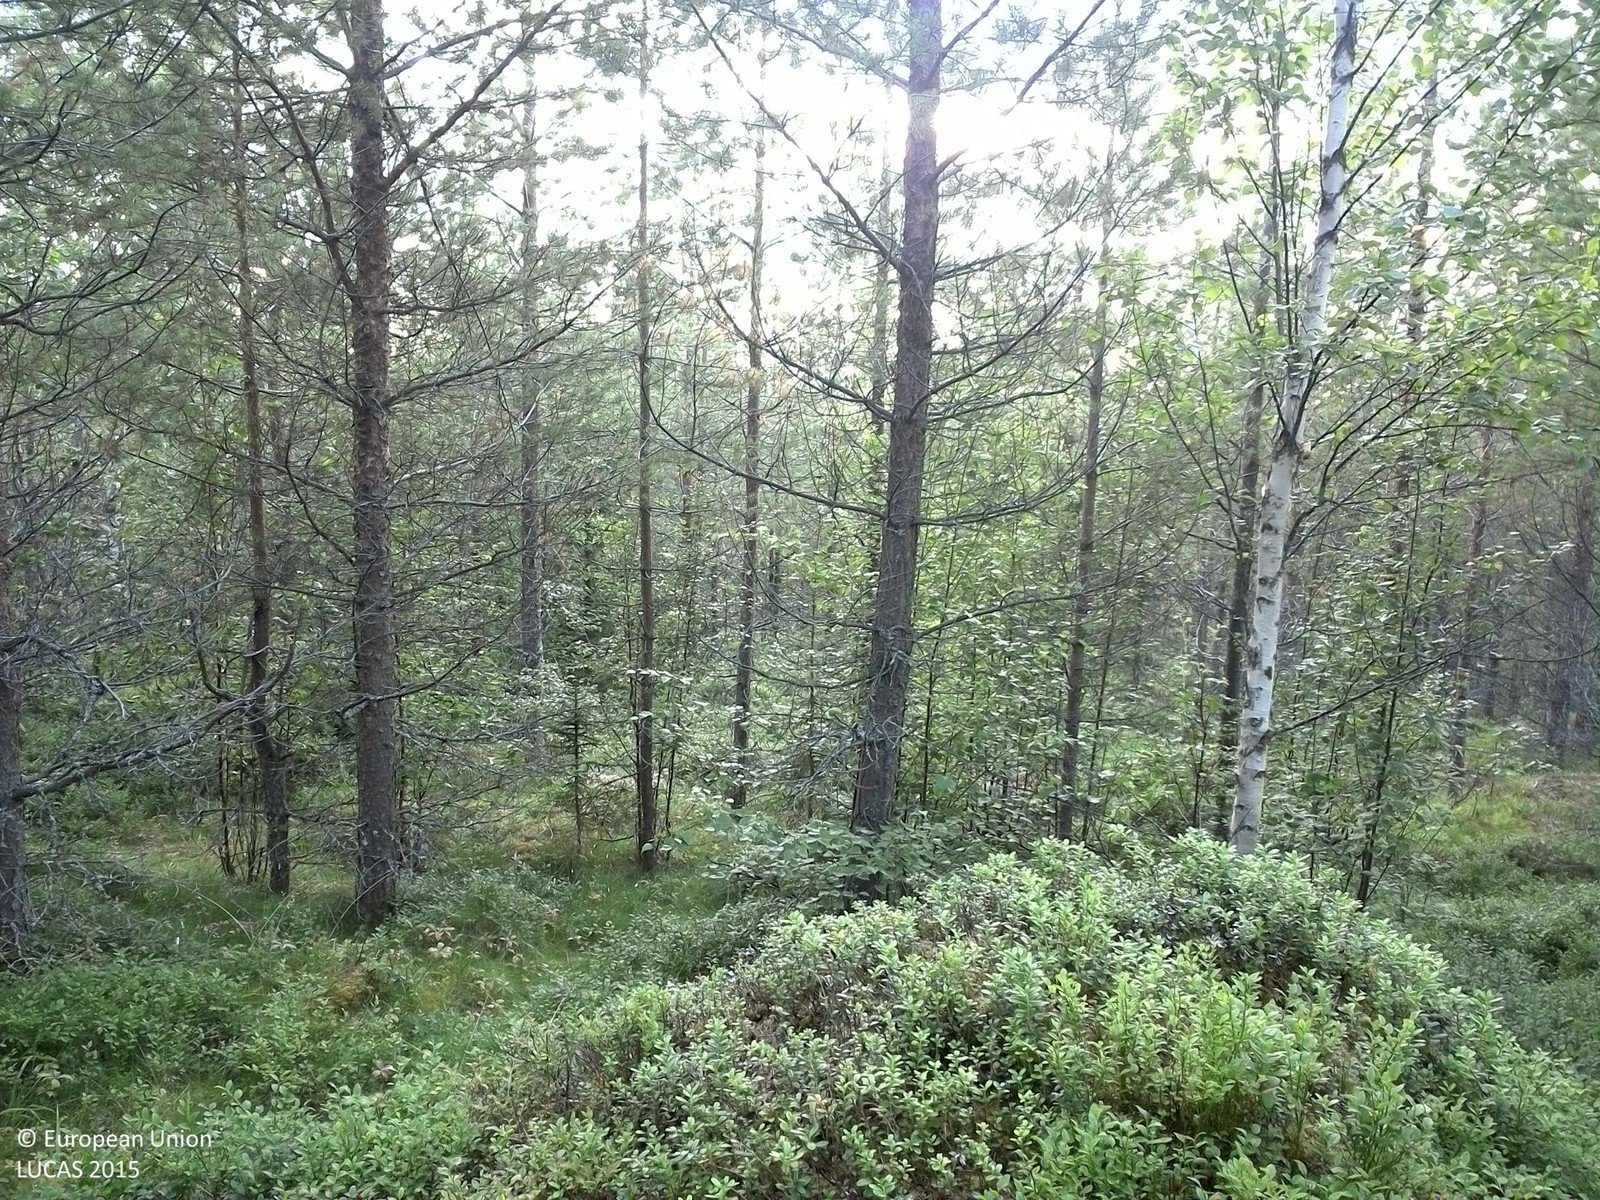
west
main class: Woodland
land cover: Pine dominated mixed woodland
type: boreal forest
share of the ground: 50 - 75 %
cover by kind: coniferous forest trees 45 %, shrubs 25 %, broadleaved forest trees 15 %, lichens and mosses 10 %, herbaceous plants 5 %
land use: Forestry
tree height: > 5 m
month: August
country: SE
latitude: 63.7405
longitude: 16.4753
